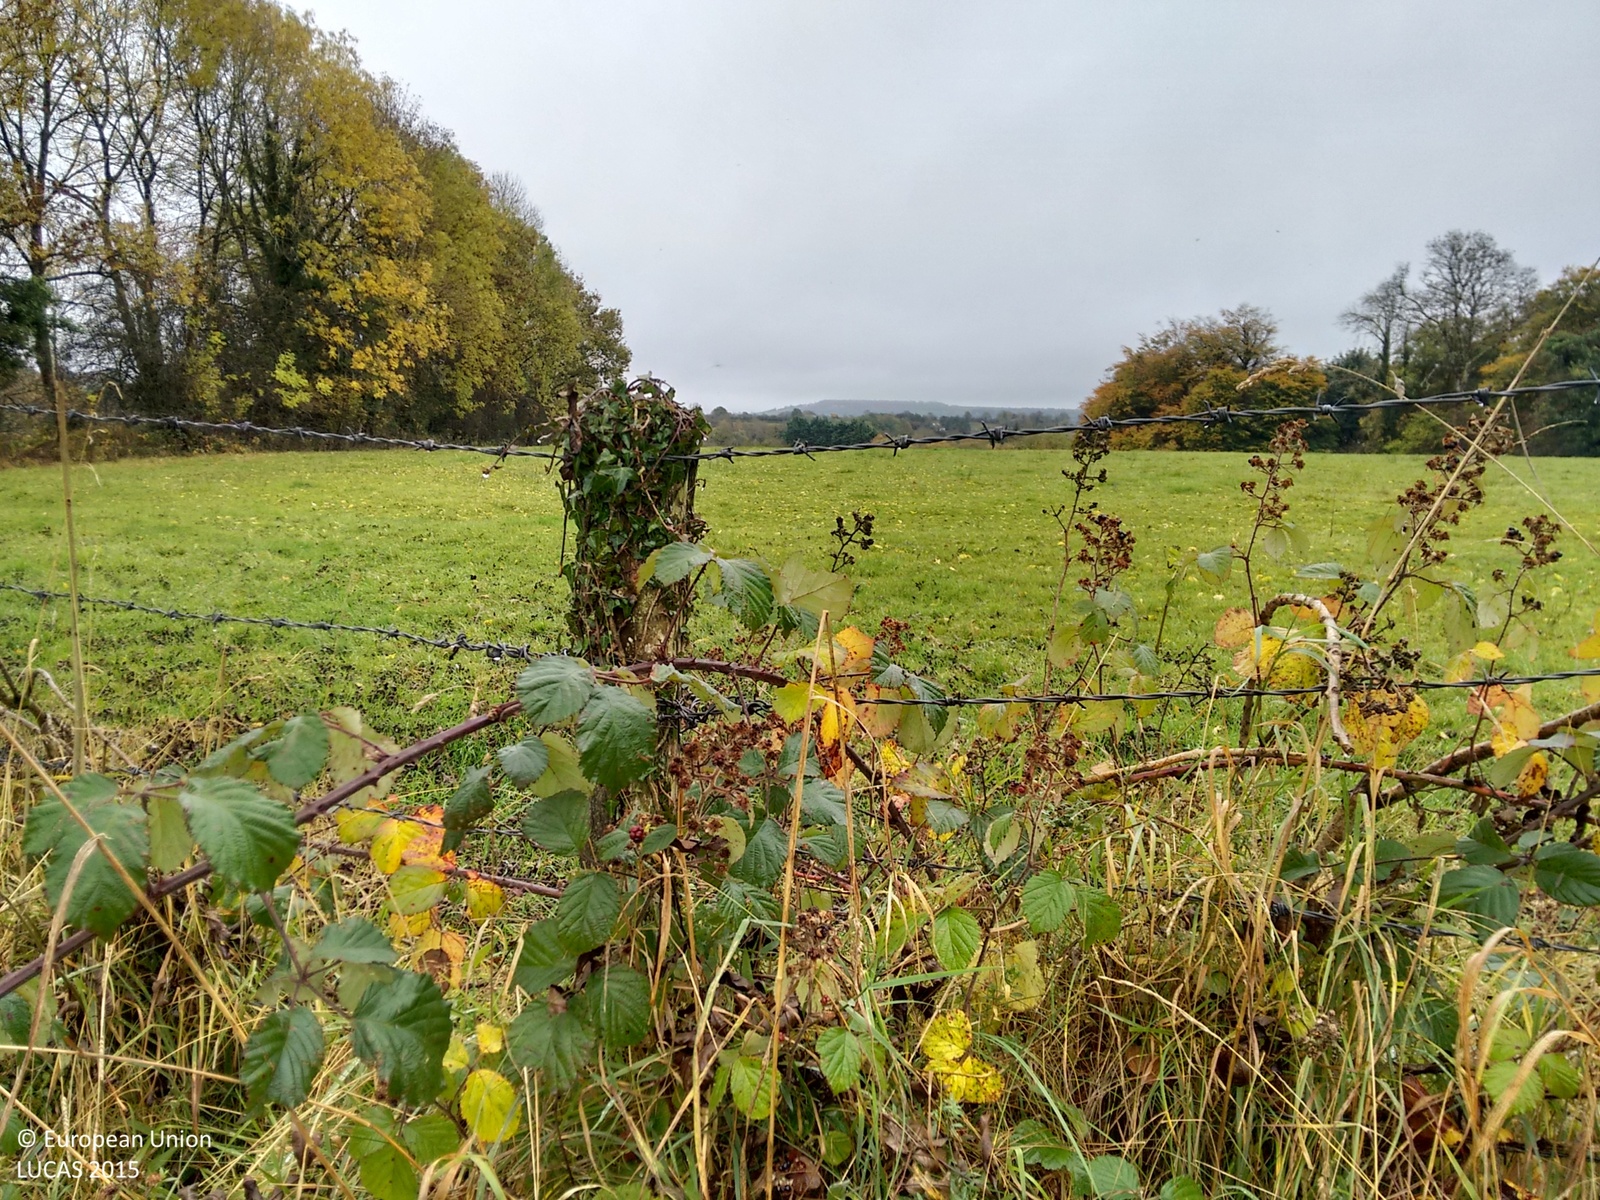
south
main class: Grassland
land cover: Grassland without tree/shrub cover
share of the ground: > 75 %
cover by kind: herbaceous plants 100 %
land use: Agriculture (excluding fallow land and kitchen gardens)
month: October
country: IE
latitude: 53.8487
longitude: -8.0995
